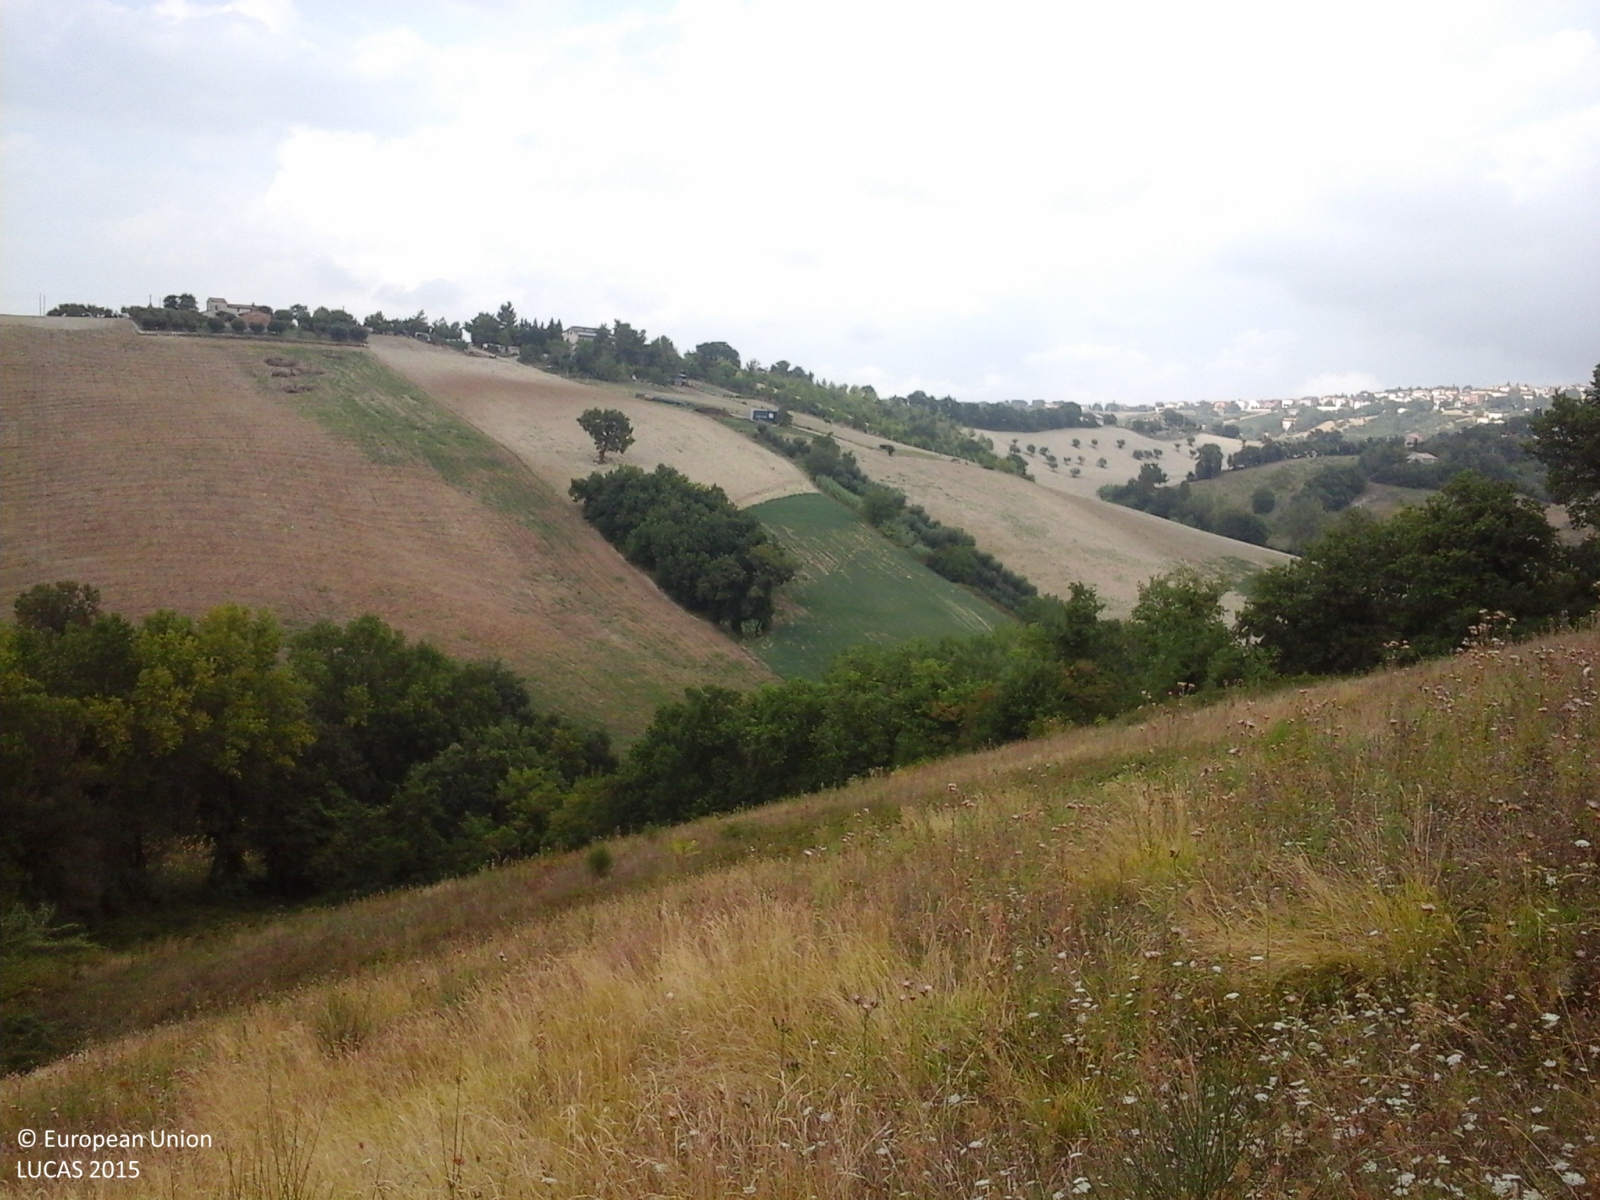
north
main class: Cropland
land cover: Sunflower
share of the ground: 25 - 50 %
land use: Agriculture (excluding fallow land and kitchen gardens)
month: August
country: IT
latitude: 43.4176
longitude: 13.1661
